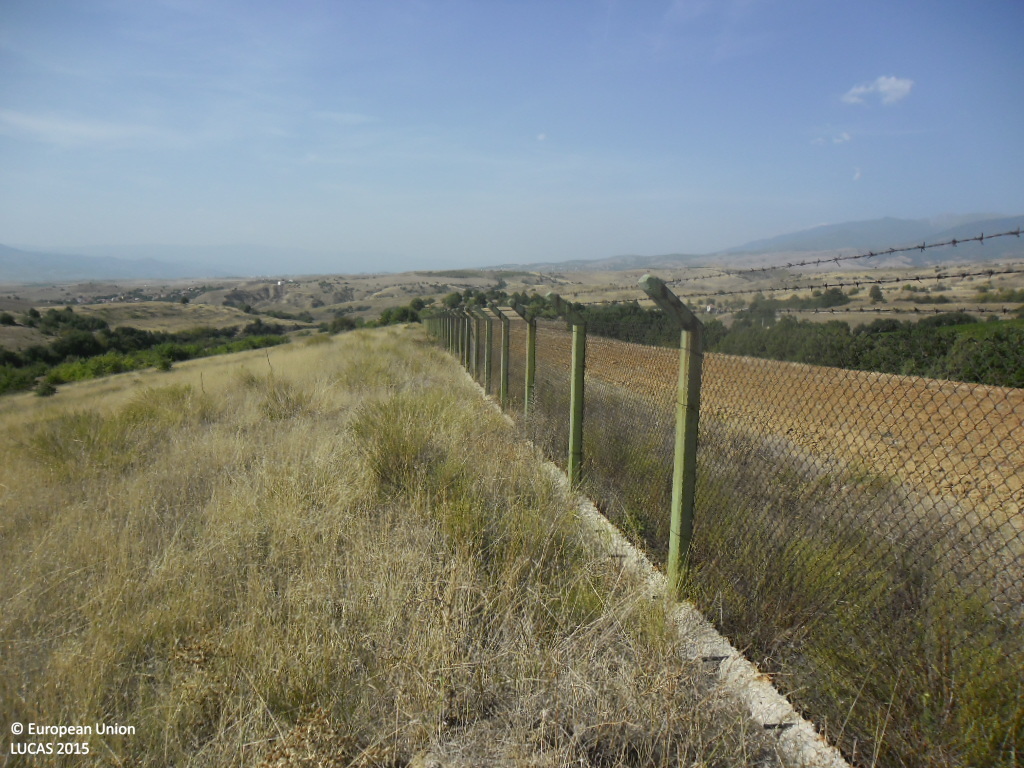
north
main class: Grassland
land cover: Spontaneously vegetated surfaces
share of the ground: 25 - 50 %
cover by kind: herbaceous plants 90 %, unconsolidated bare surface 10 %
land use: Agriculture (excluding fallow land and kitchen gardens)
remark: Harvested field
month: September
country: BG
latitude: 41.4911
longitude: 23.3534
